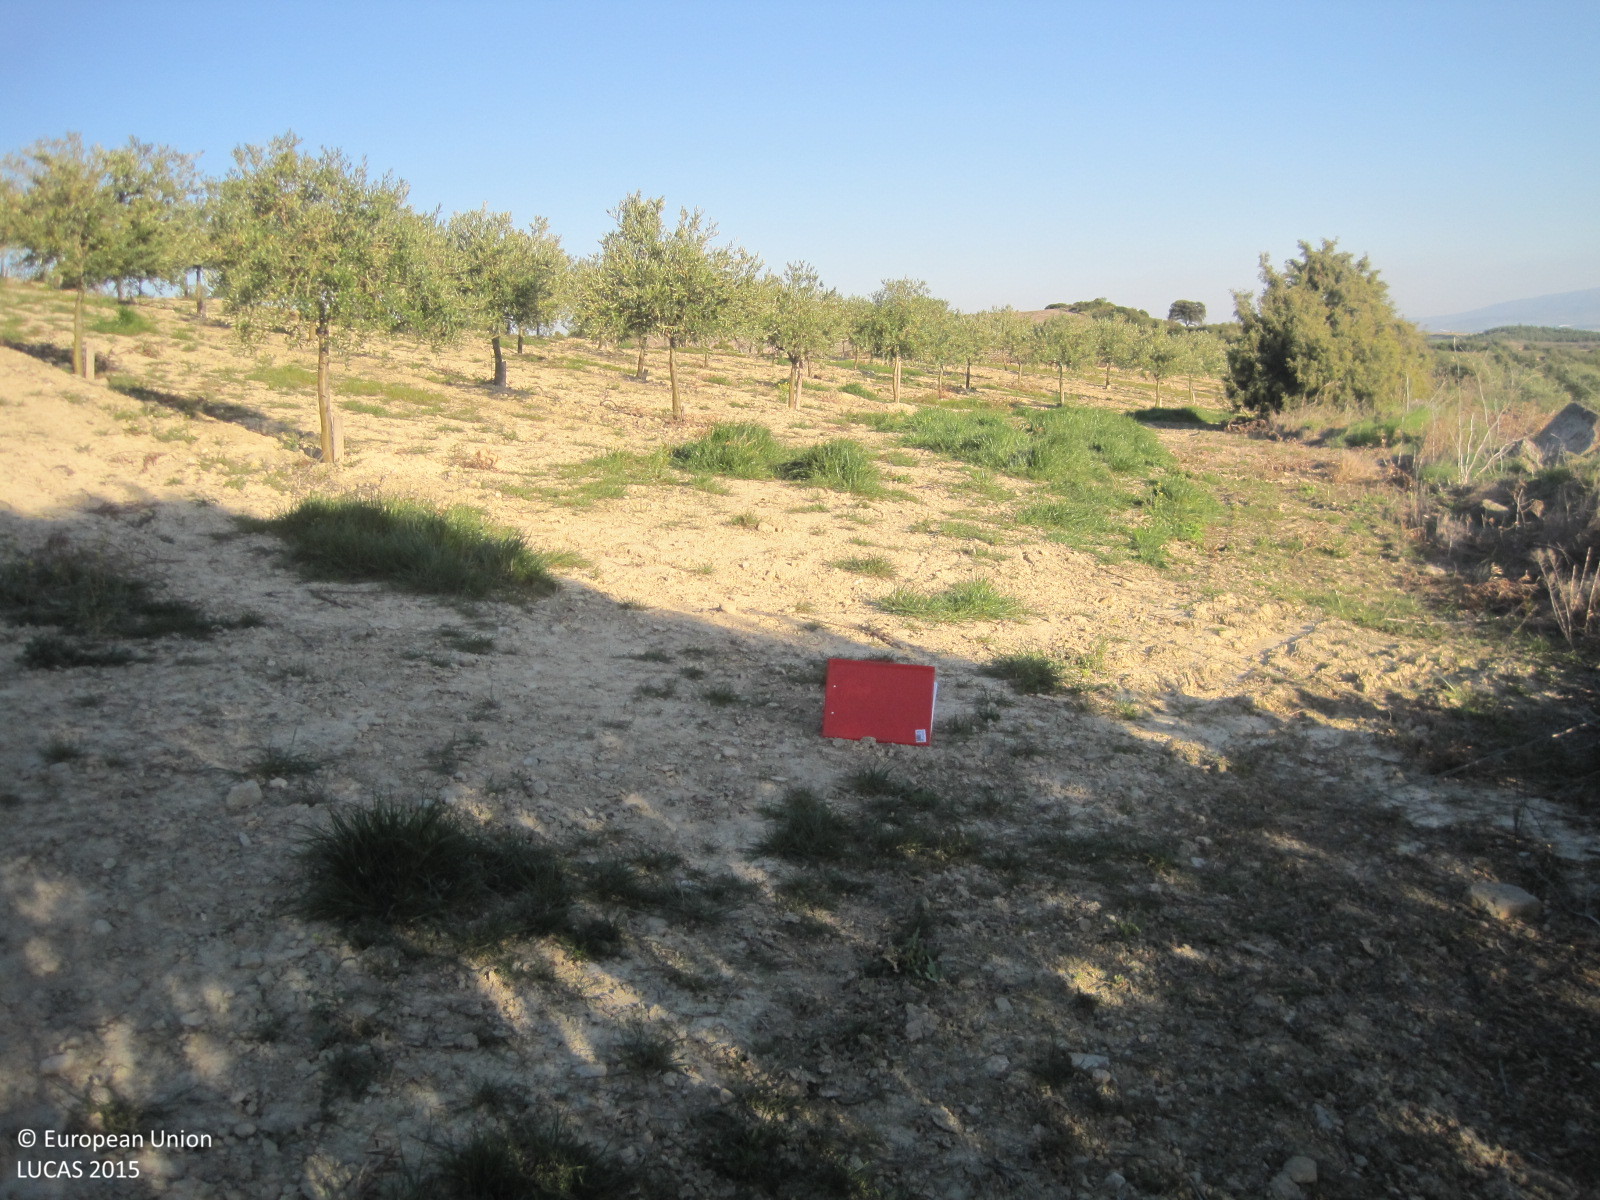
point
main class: Cropland
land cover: Olive groves
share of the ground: 10 - 25 %
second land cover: Other bare soil
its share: > 75 %
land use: Agriculture (excluding fallow land and kitchen gardens)
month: April
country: ES
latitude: 42.5393
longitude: -2.4531
